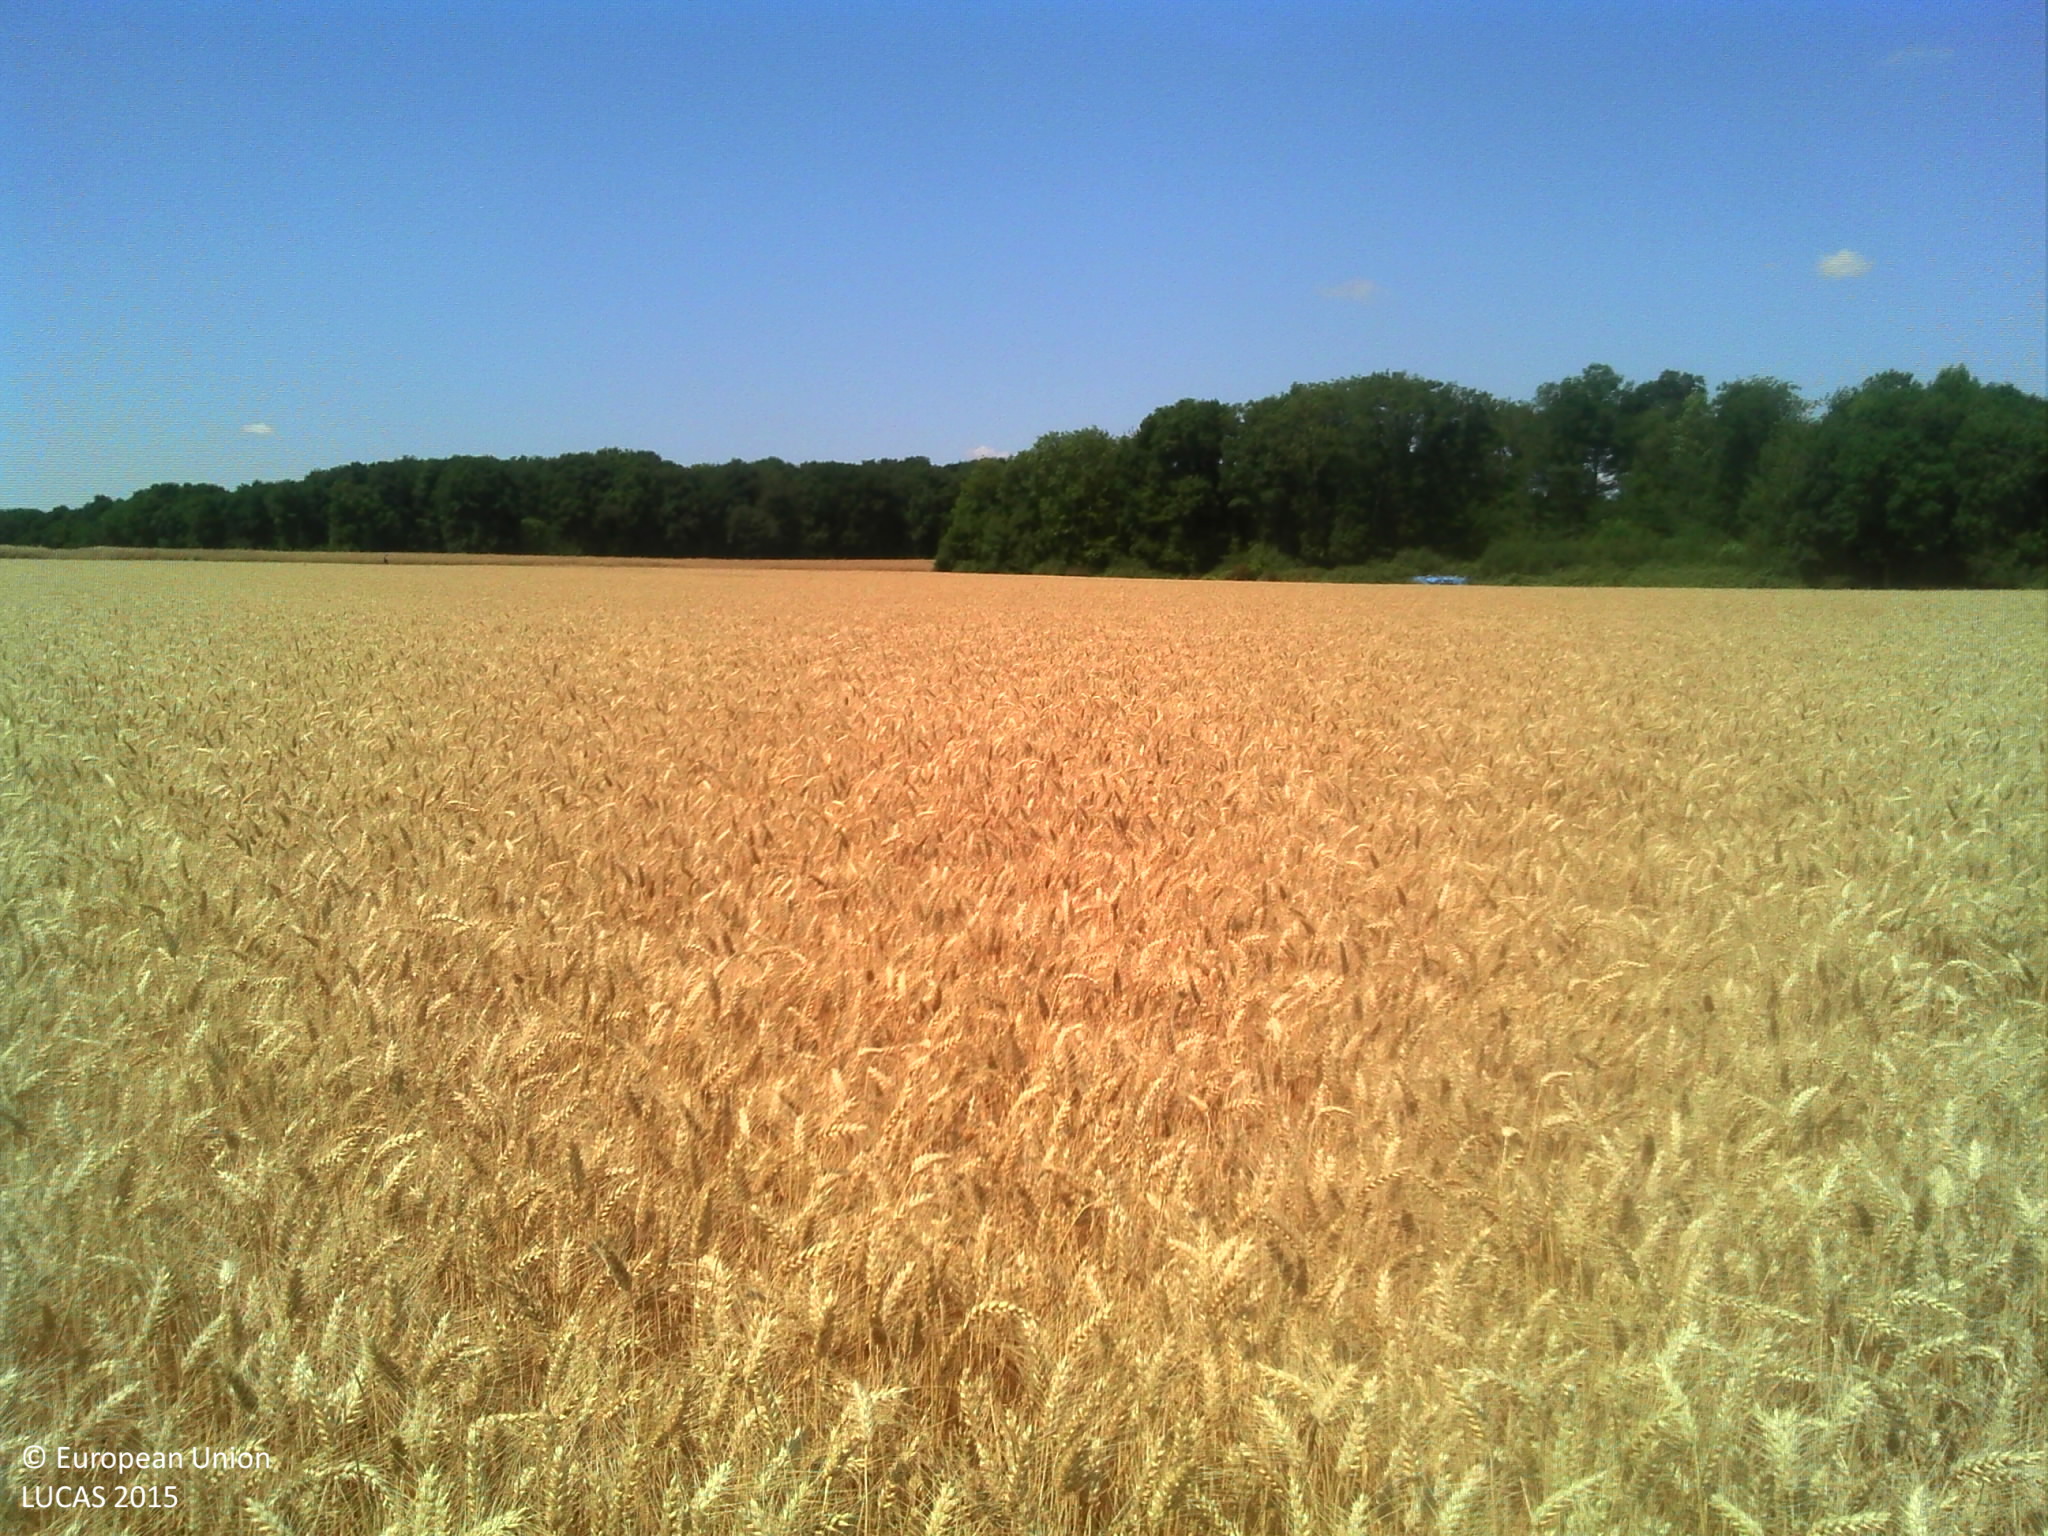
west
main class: Cropland
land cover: Common wheat
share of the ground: > 75 %
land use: Agriculture (excluding fallow land and kitchen gardens)
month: July
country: FR
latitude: 48.1494
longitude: 1.2860
